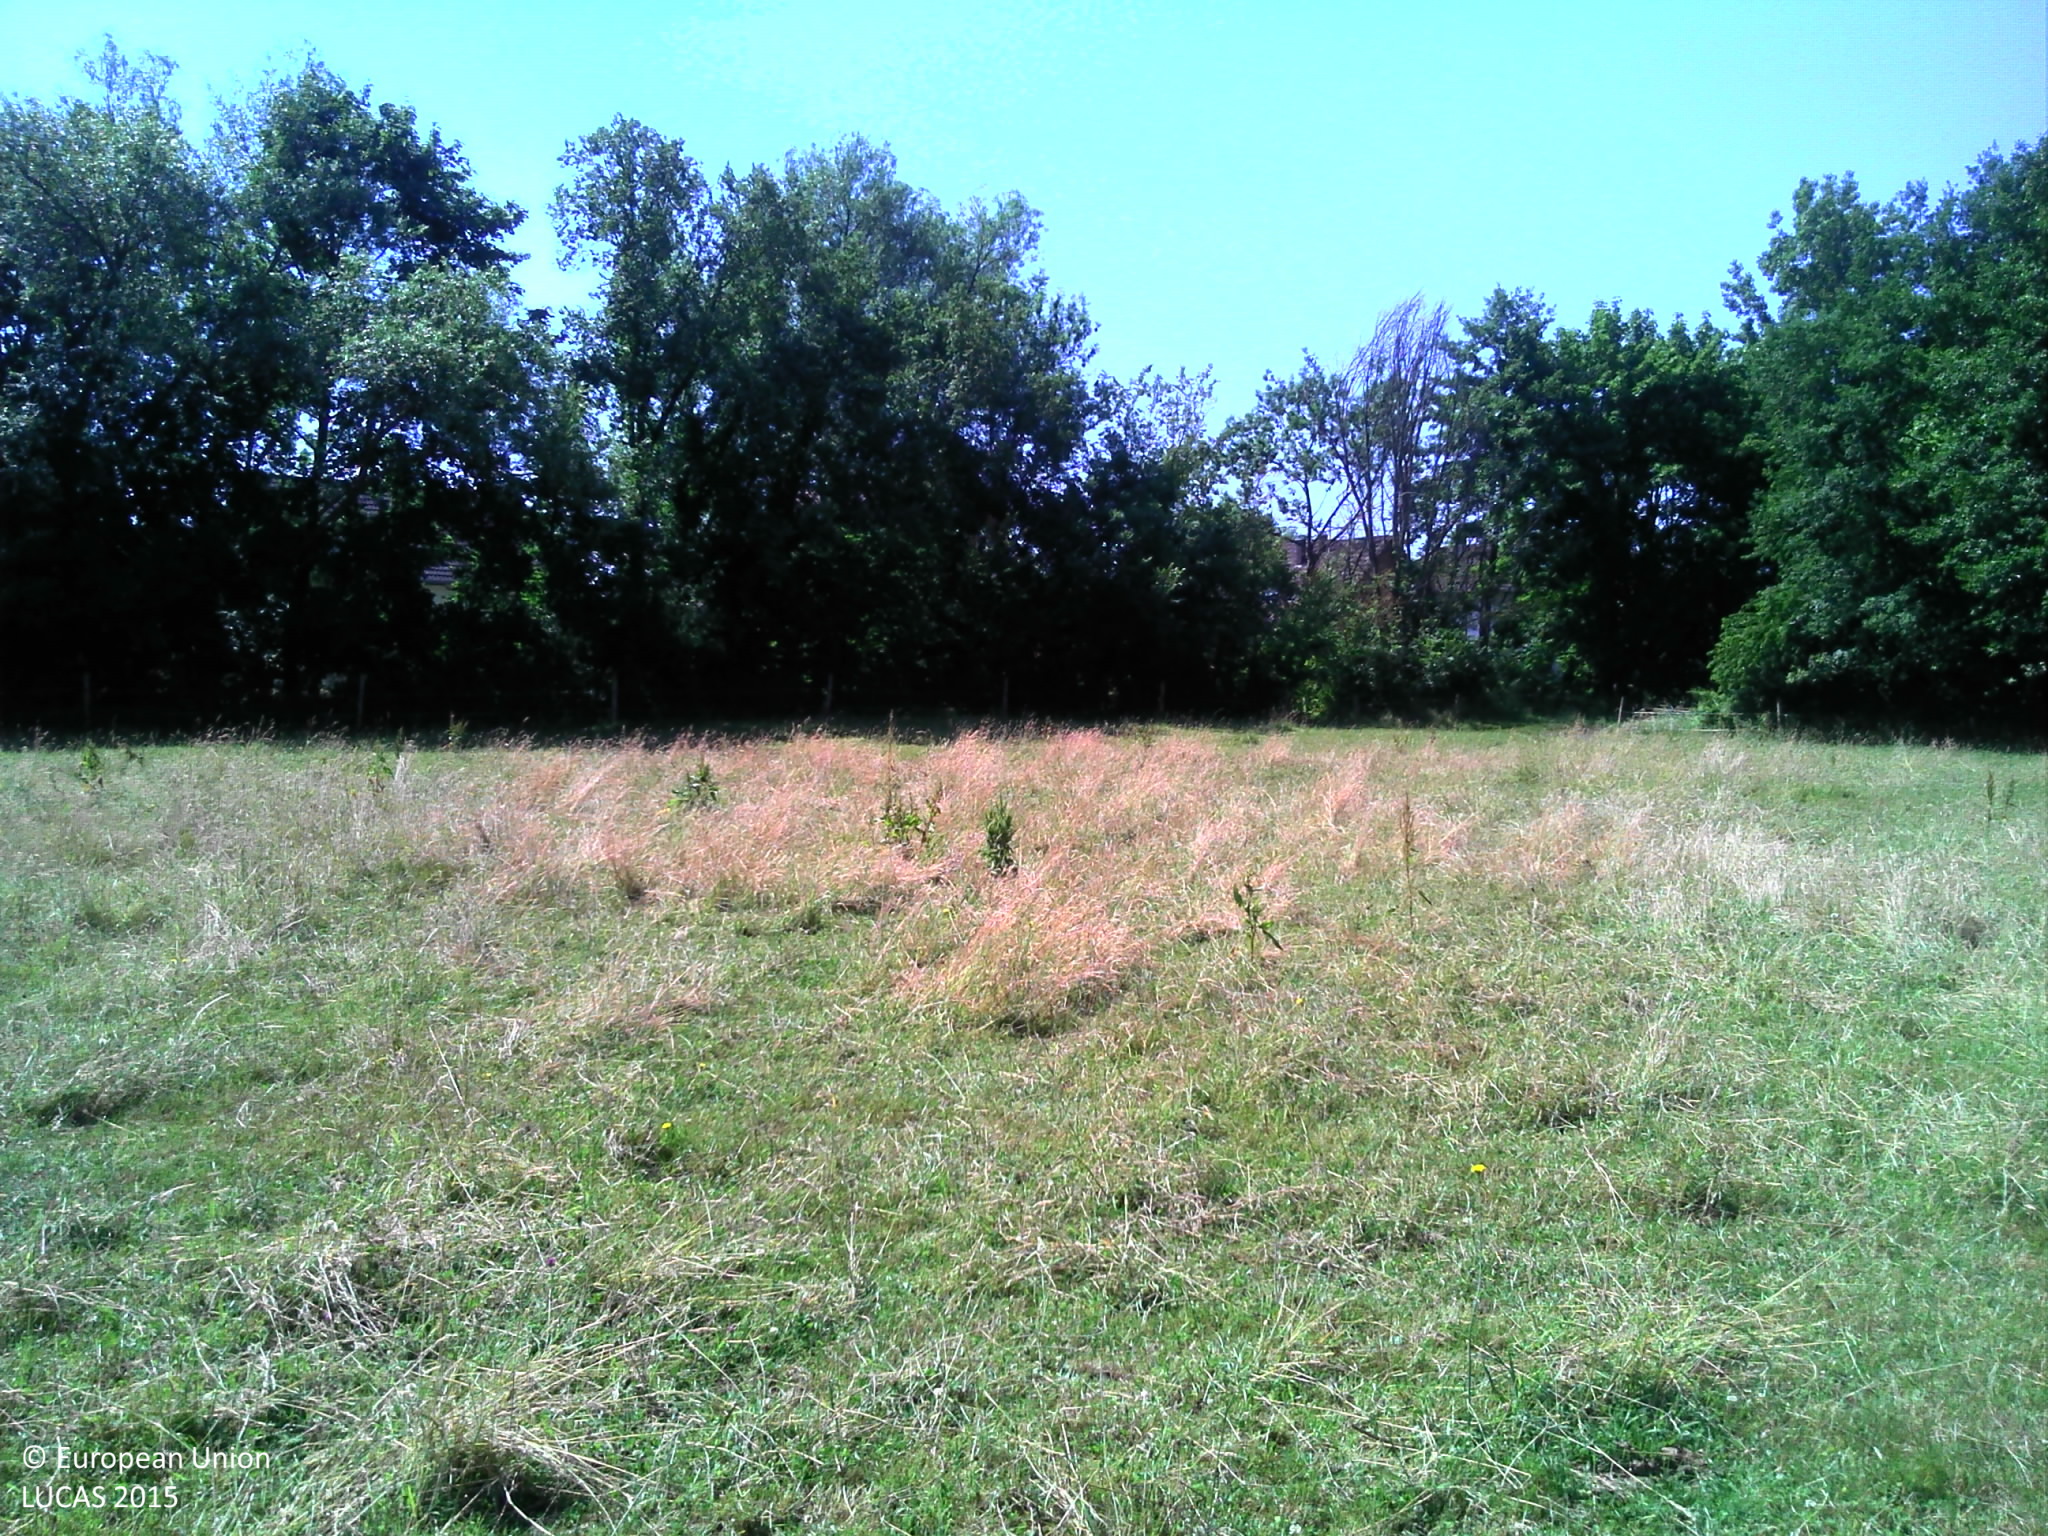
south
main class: Grassland
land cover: Grassland without tree/shrub cover
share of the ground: > 75 %
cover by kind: herbaceous plants 100 %
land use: Agriculture (excluding fallow land and kitchen gardens)
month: June
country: FR
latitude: 48.7504
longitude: 7.3757
